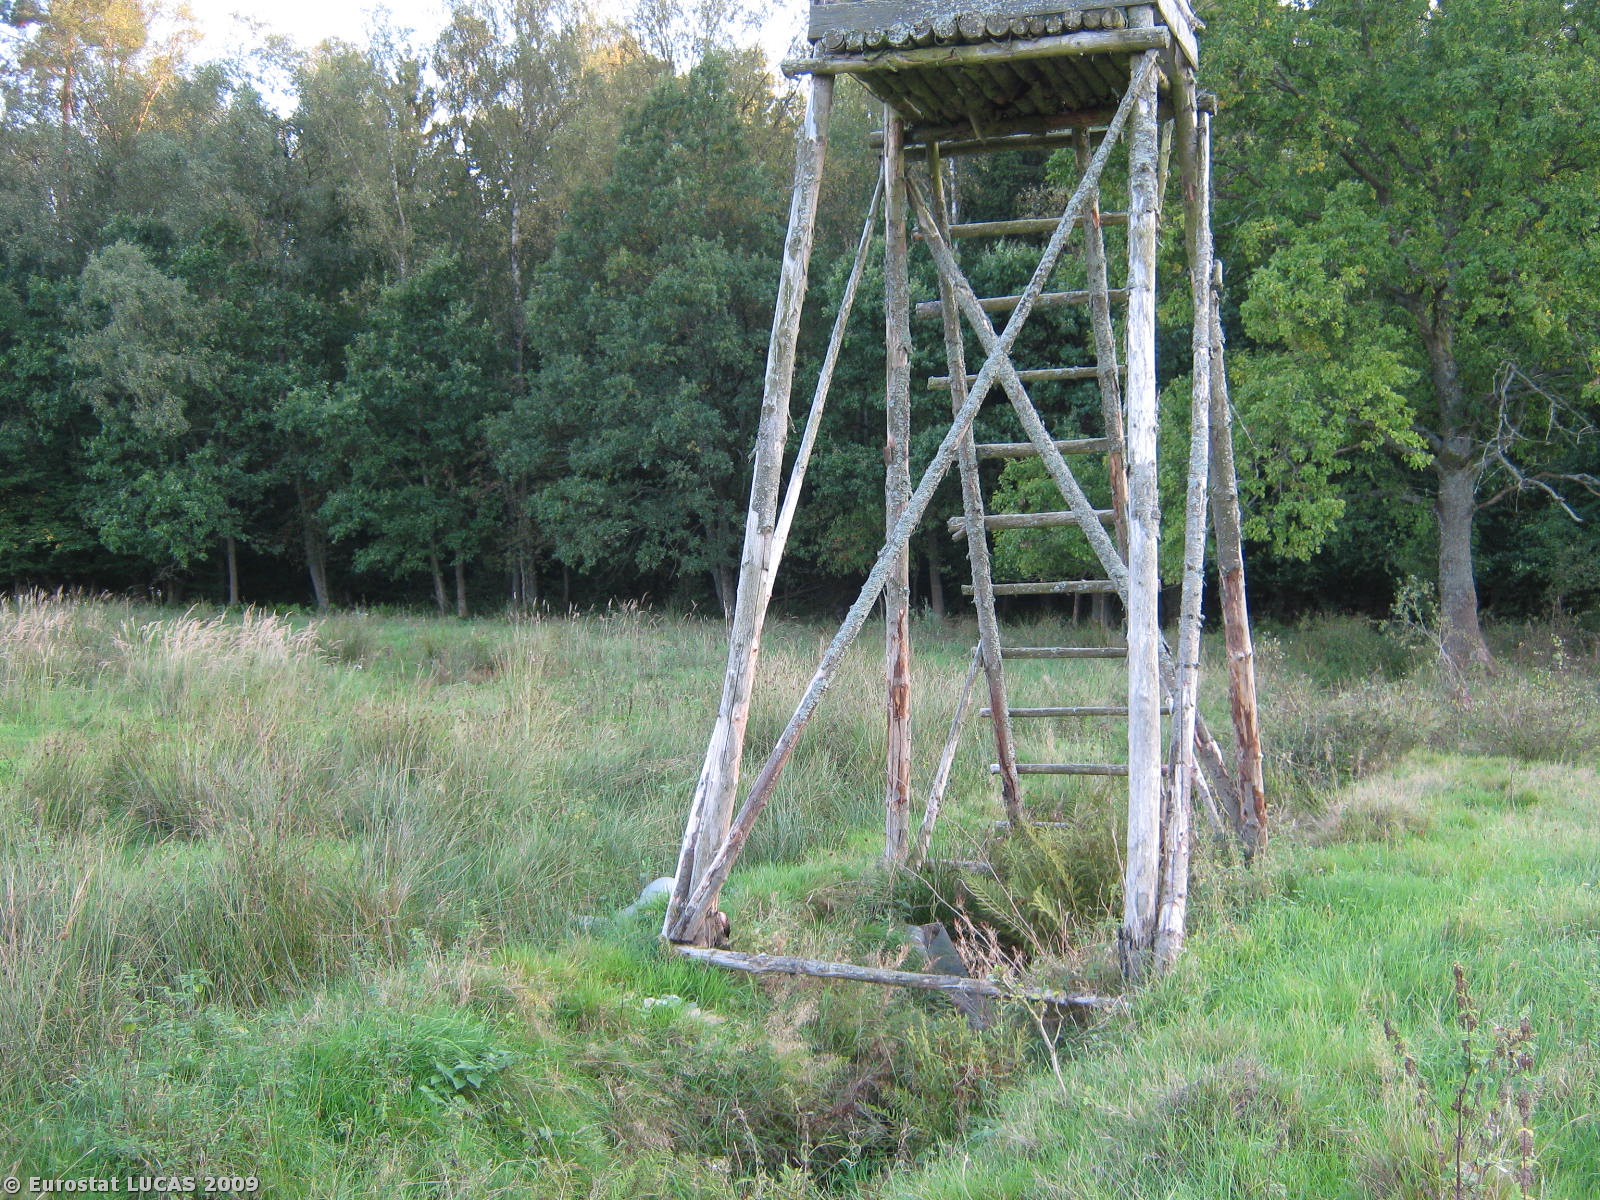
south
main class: Grassland
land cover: Grassland without tree/shrub cover
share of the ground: > 75 %
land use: Agriculture (excluding fallow land and kitchen gardens)
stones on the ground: < 10 %
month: September
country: PL
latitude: 53.8691
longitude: 15.5541
